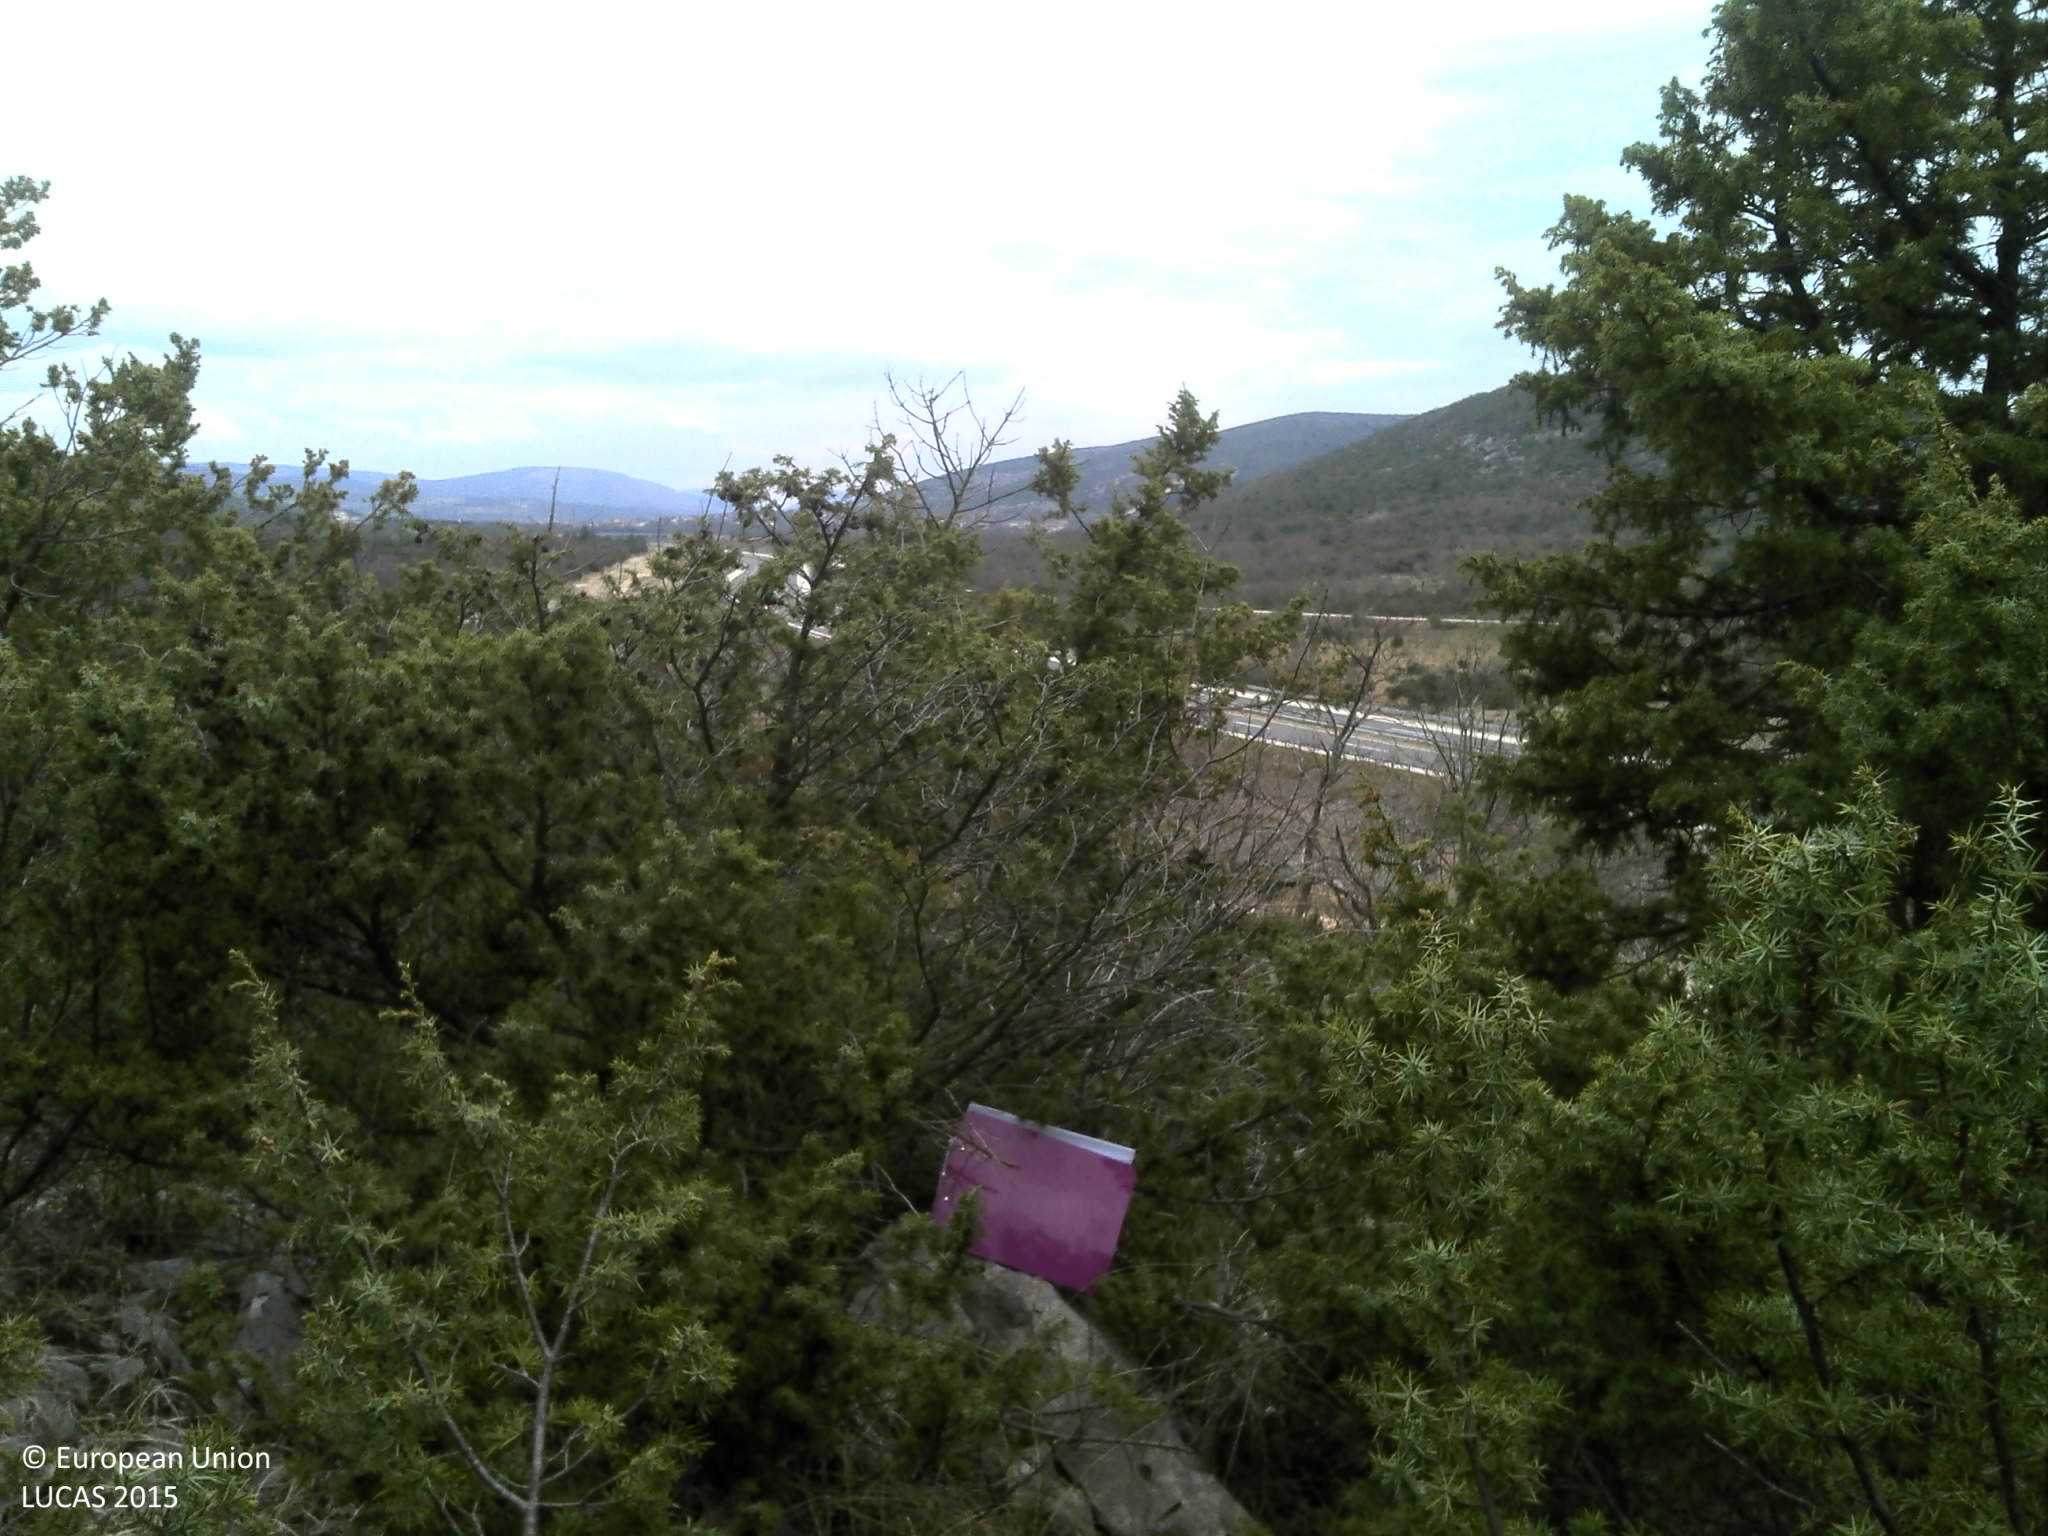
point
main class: Woodland
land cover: Other mixed woodland
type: coniferous forest of the mediterranean region
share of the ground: 50 - 75 %
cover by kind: coniferous forest trees 35 %, shrubs 25 %, broadleaved forest trees 15 %, consolidated bare surface 10 %, unconsolidated bare surface 10 %, herbaceous plants 5 %
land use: Semi-natural and natural areas not in use
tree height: < 5 m
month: April
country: HR
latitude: 43.6838
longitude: 16.0820
